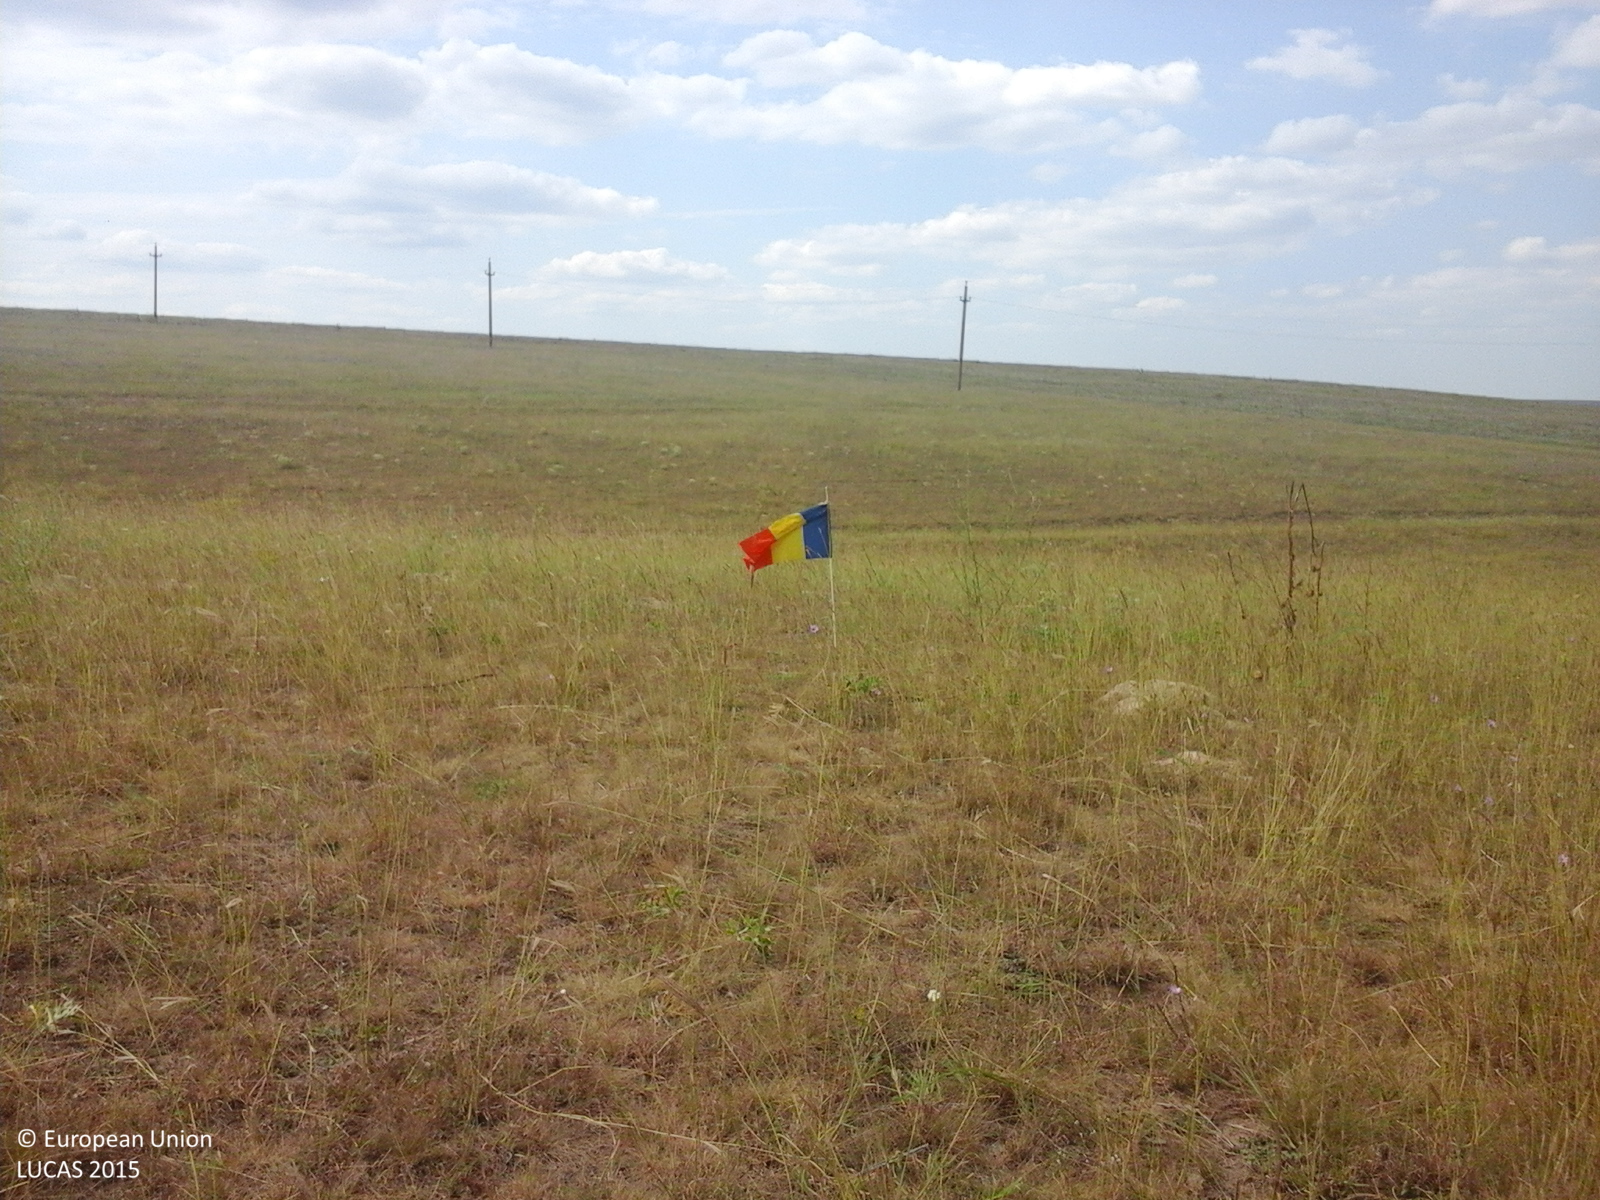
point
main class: Grassland
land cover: Grassland without tree/shrub cover
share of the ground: > 75 %
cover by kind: herbaceous plants 100 %
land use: Agriculture (excluding fallow land and kitchen gardens)
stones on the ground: < 10 %
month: August
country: RO
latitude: 44.7205
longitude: 28.1815
